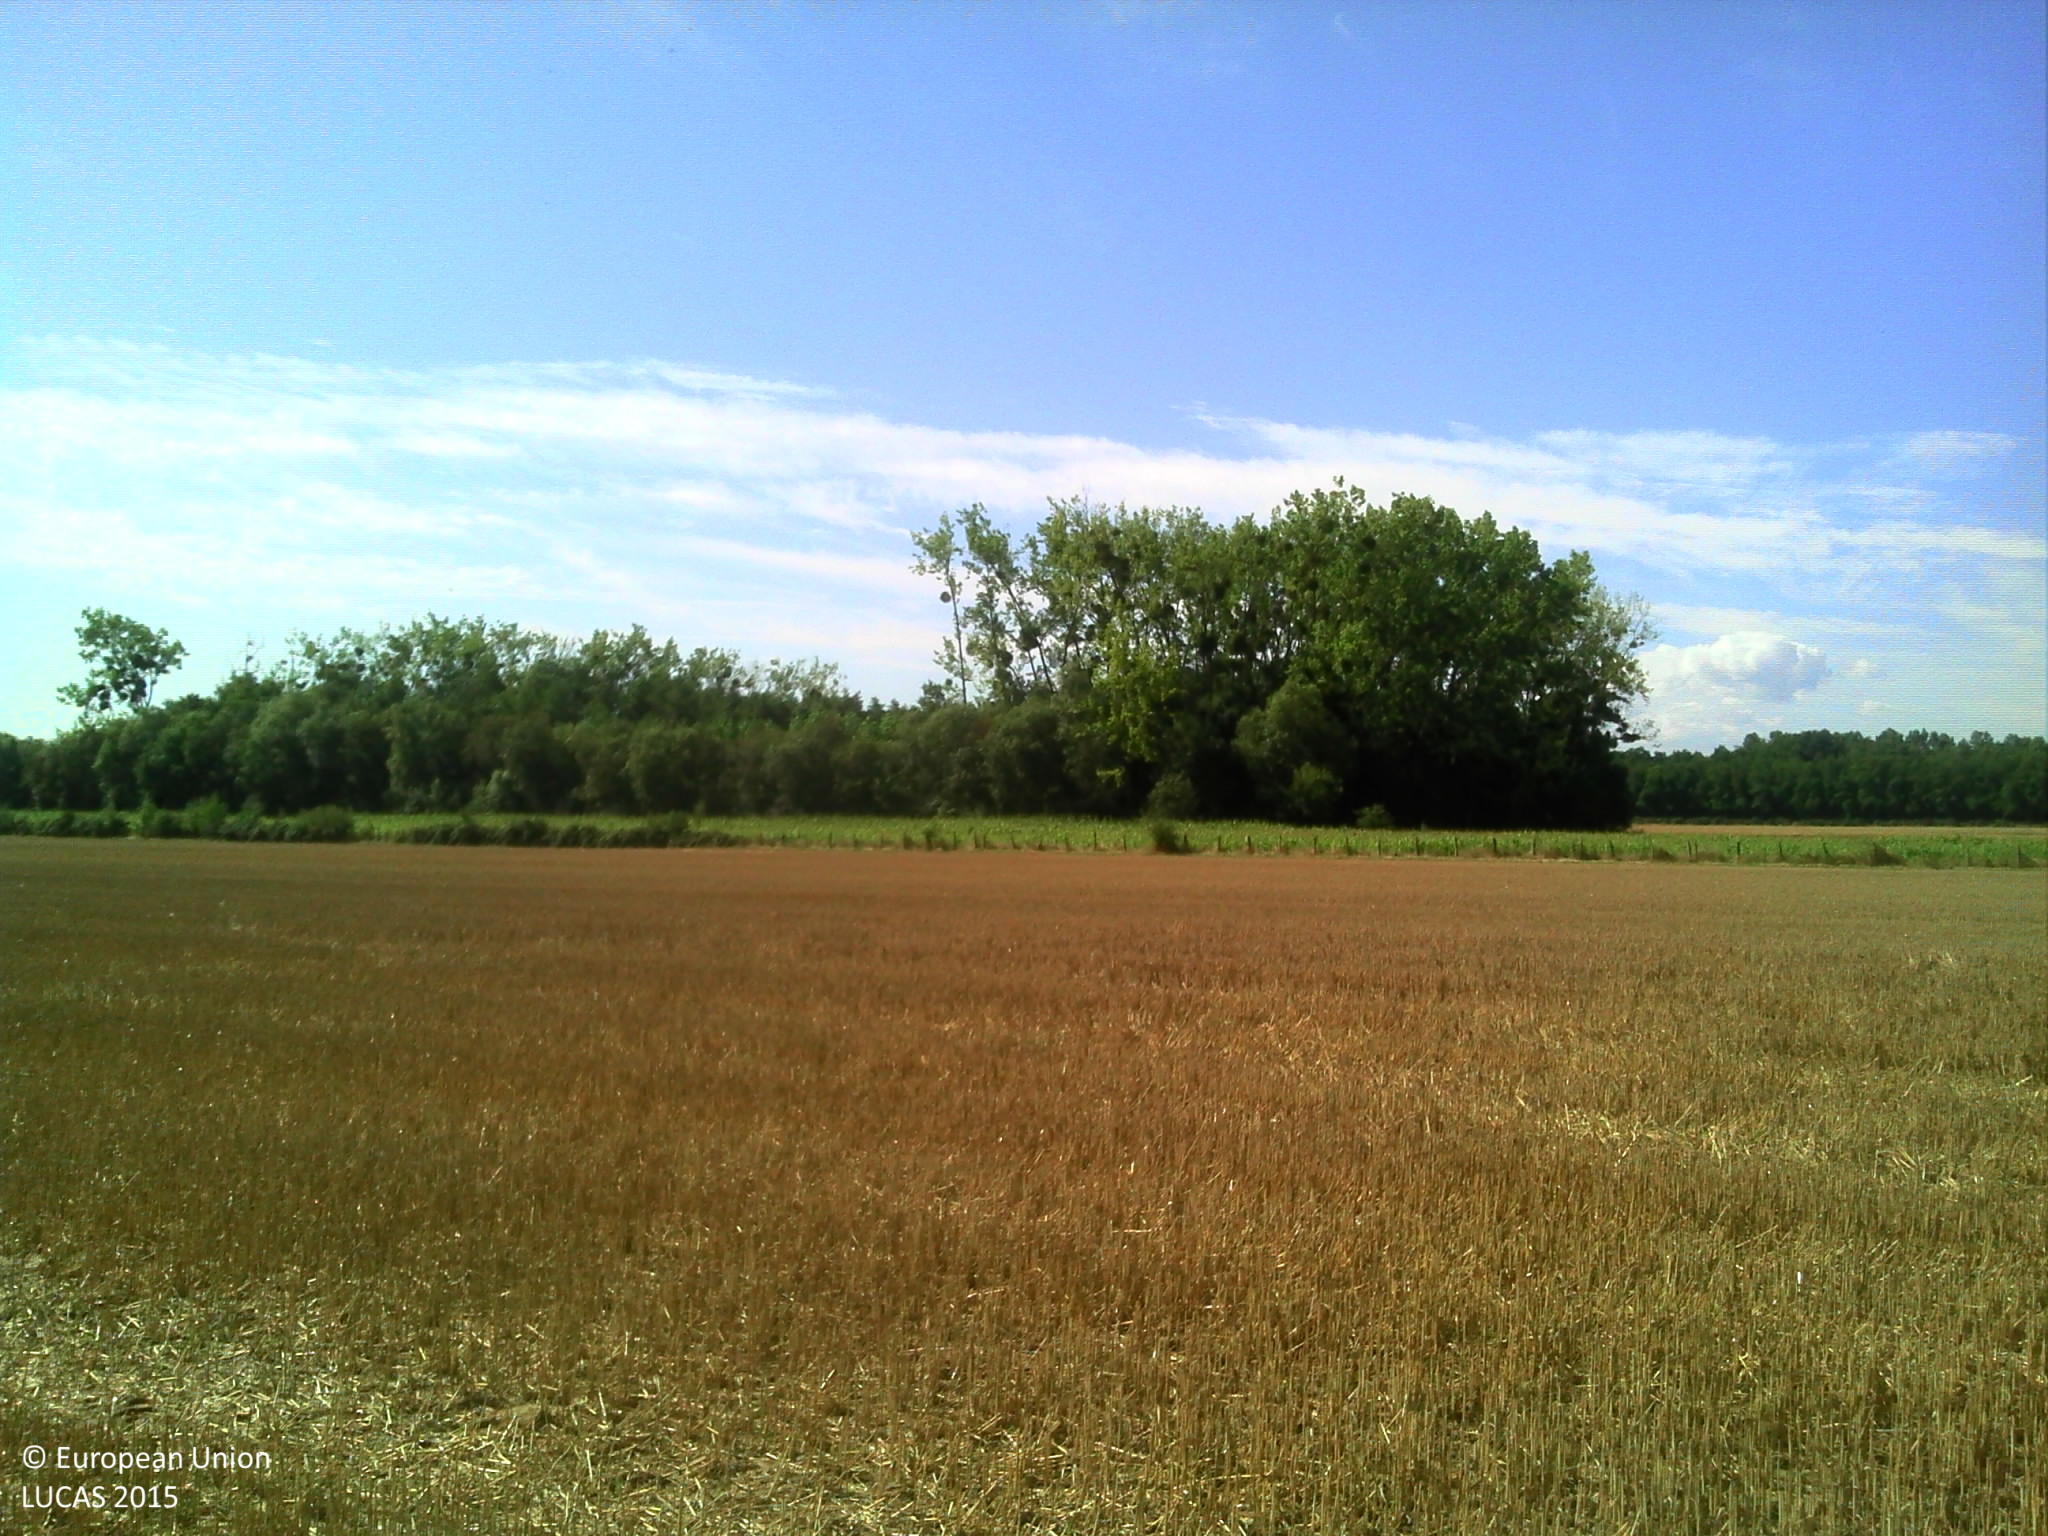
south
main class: Cropland
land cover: Common wheat
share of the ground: > 75 %
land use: Agriculture (excluding fallow land and kitchen gardens)
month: July
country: FR
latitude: 46.7725
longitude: 4.9334
